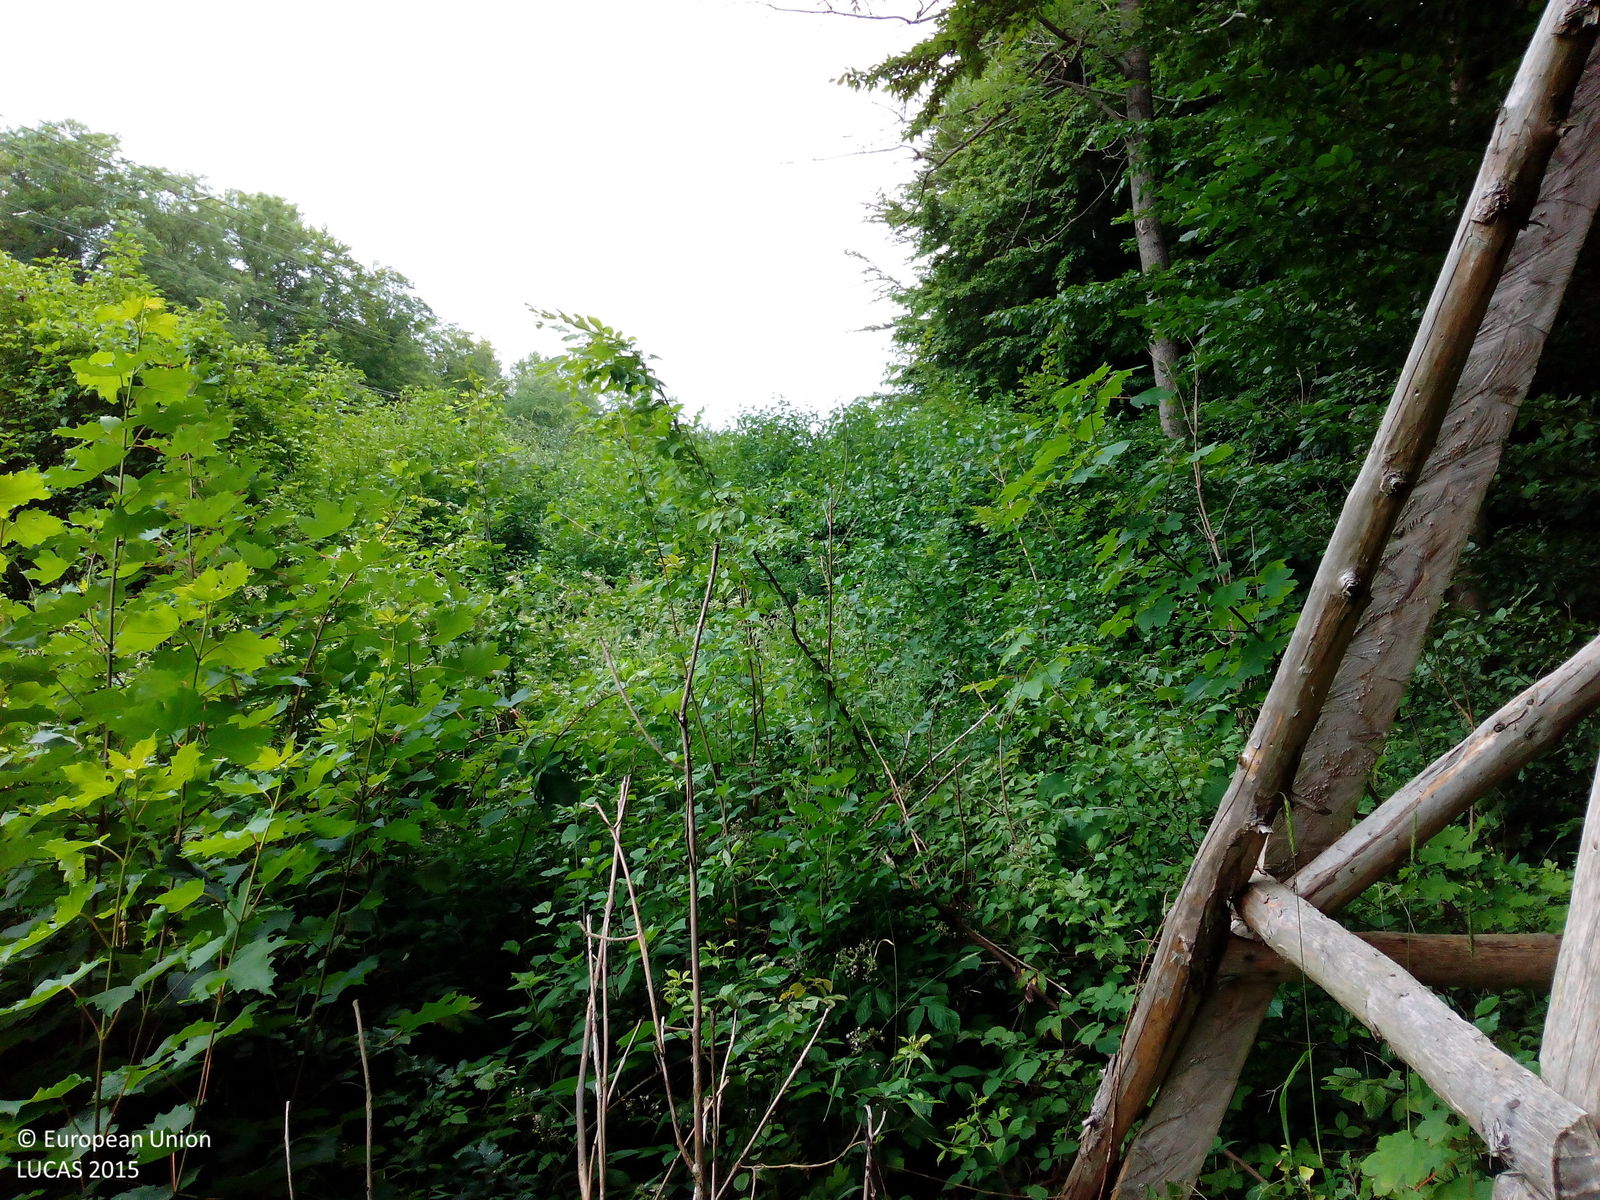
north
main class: Artificial land
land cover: Other artificial areas
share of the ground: > 75 %
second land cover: Shrubland with sparse tree cover
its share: > 75 %
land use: Electricity, gas and thermal power distribution
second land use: Forestry
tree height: > 5 m
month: July
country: DE
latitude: 51.5686
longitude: 9.9567
